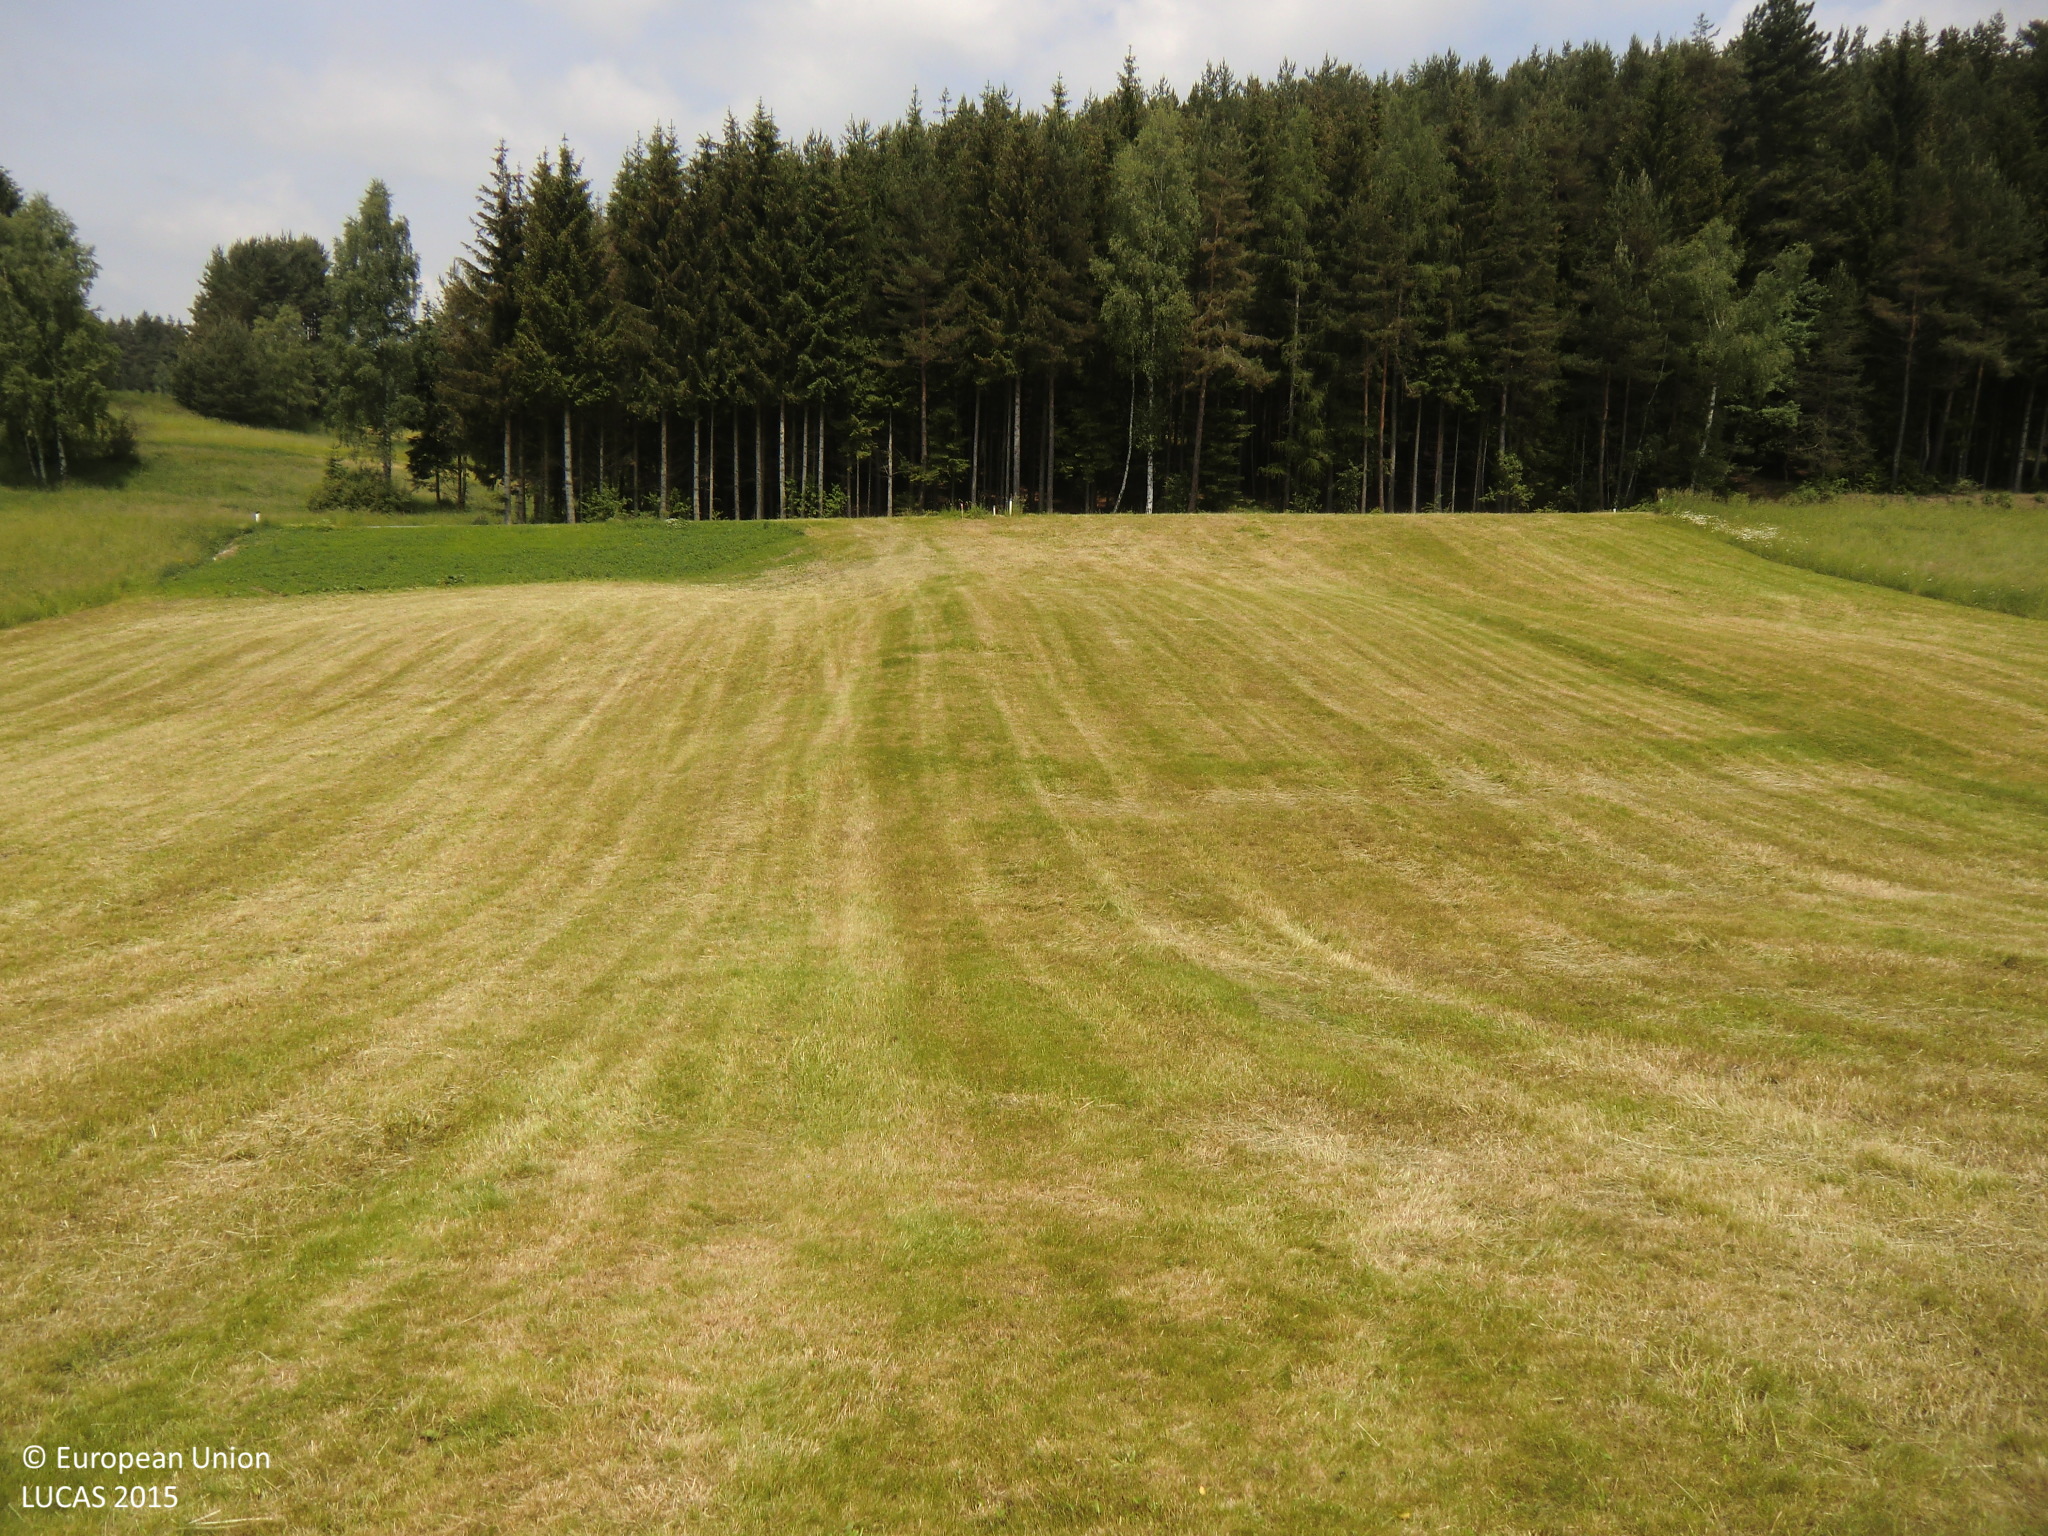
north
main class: Grassland
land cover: Grassland without tree/shrub cover
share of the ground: > 75 %
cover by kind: herbaceous plants 100 %
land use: Agriculture (excluding fallow land and kitchen gardens)
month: June
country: AT
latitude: 48.6386
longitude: 14.8734
